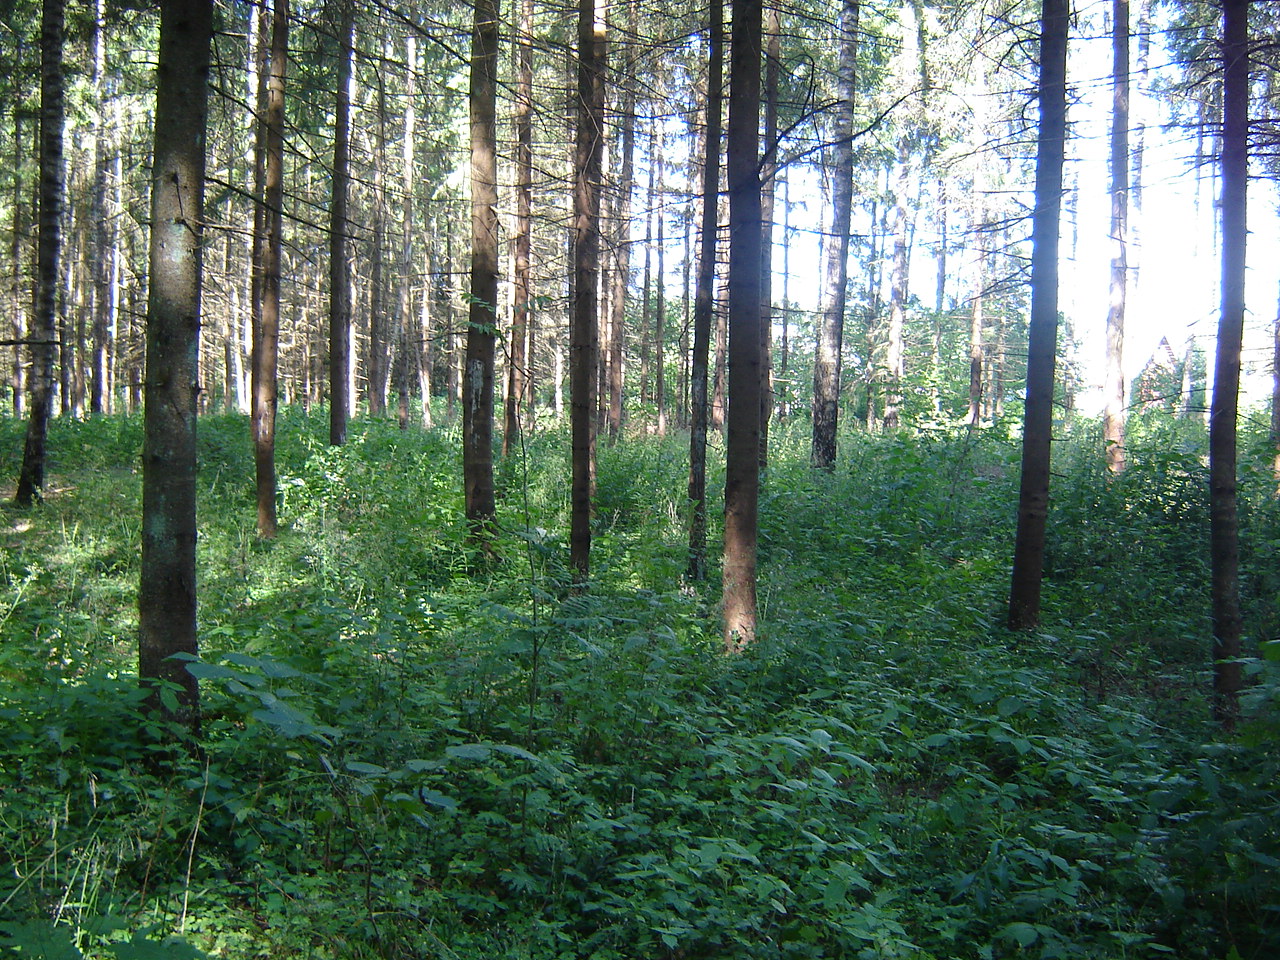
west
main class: Woodland
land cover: Spruce dominated mixed woodland
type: hemiboreal forest and nemoral coniferous forest and mixed broadleaved-coniferous forest
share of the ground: > 75 %
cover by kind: coniferous forest trees 55 %, broadleaved forest trees 25 %, herbaceous plants 10 %, shrubs 5 %, lichens and mosses 5 %
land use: Forestry
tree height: > 5 m
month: August
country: LT
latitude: 54.8188
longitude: 25.3270
